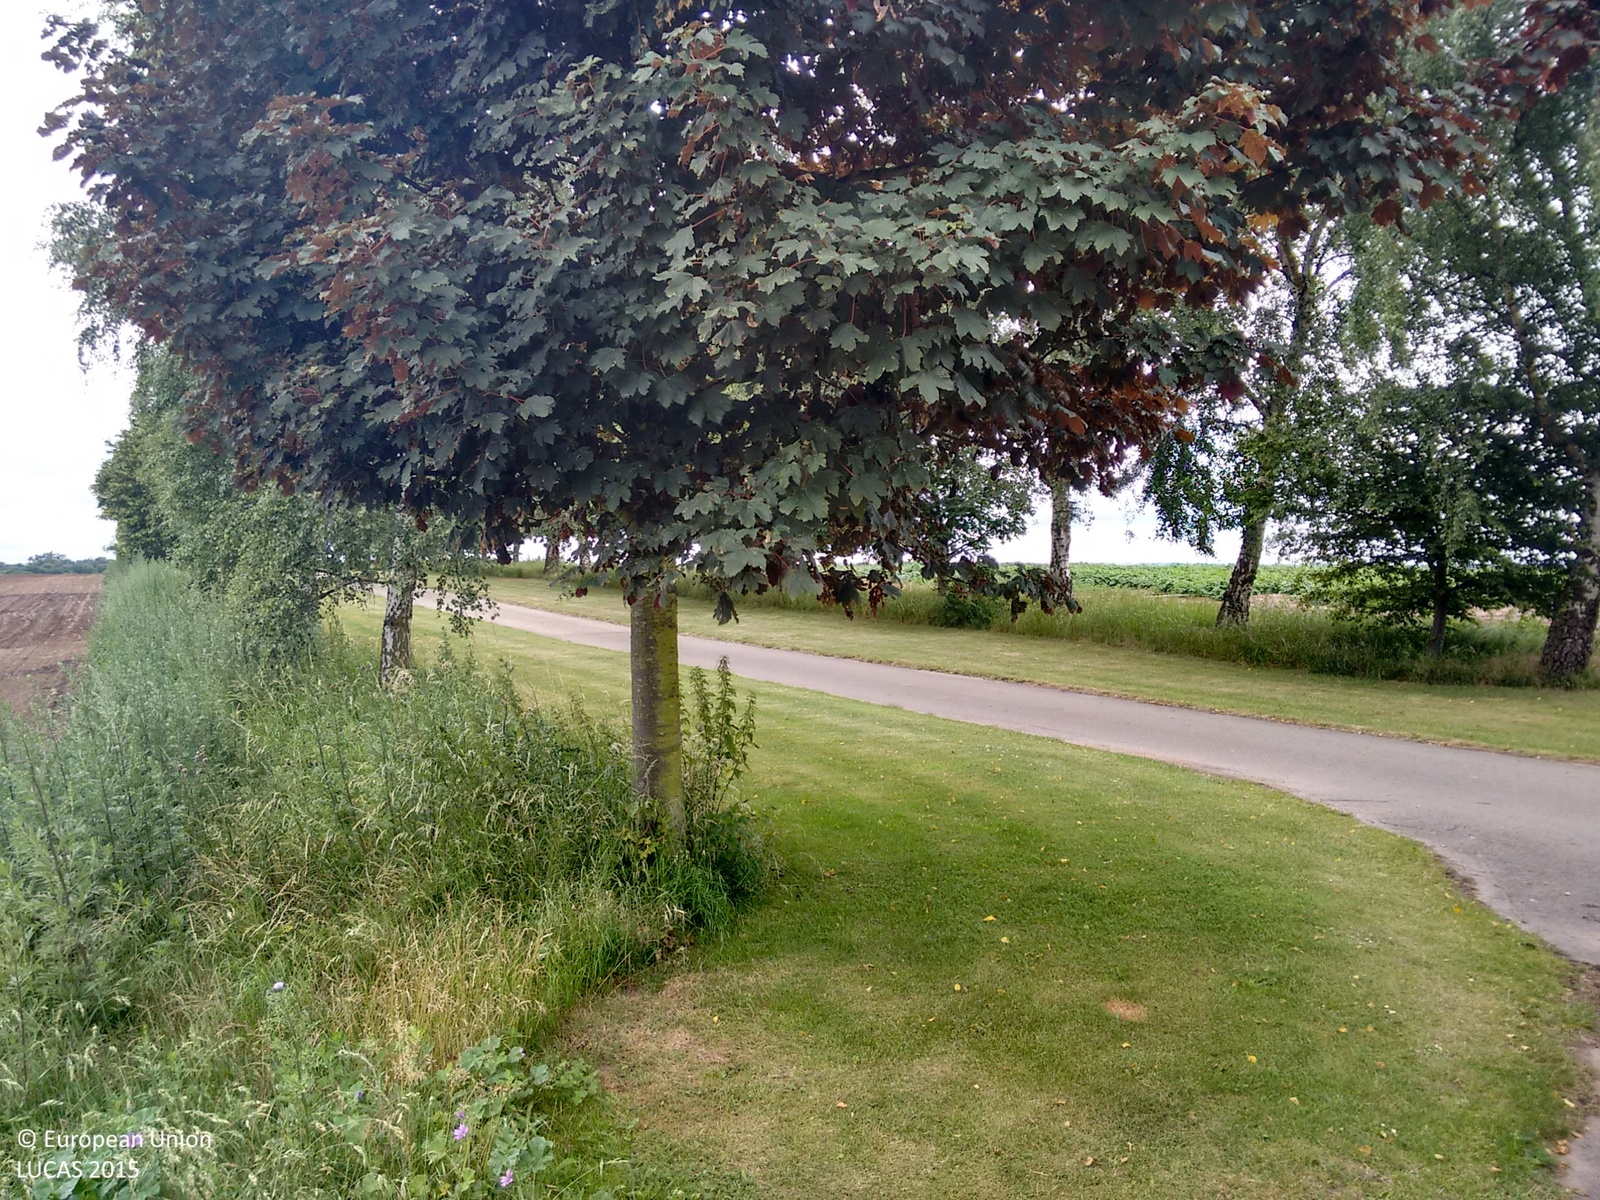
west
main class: Cropland
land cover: Potatoes
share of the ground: > 75 %
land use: Agriculture (excluding fallow land and kitchen gardens)
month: July
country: GB
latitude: 53.3656
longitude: -1.0598
